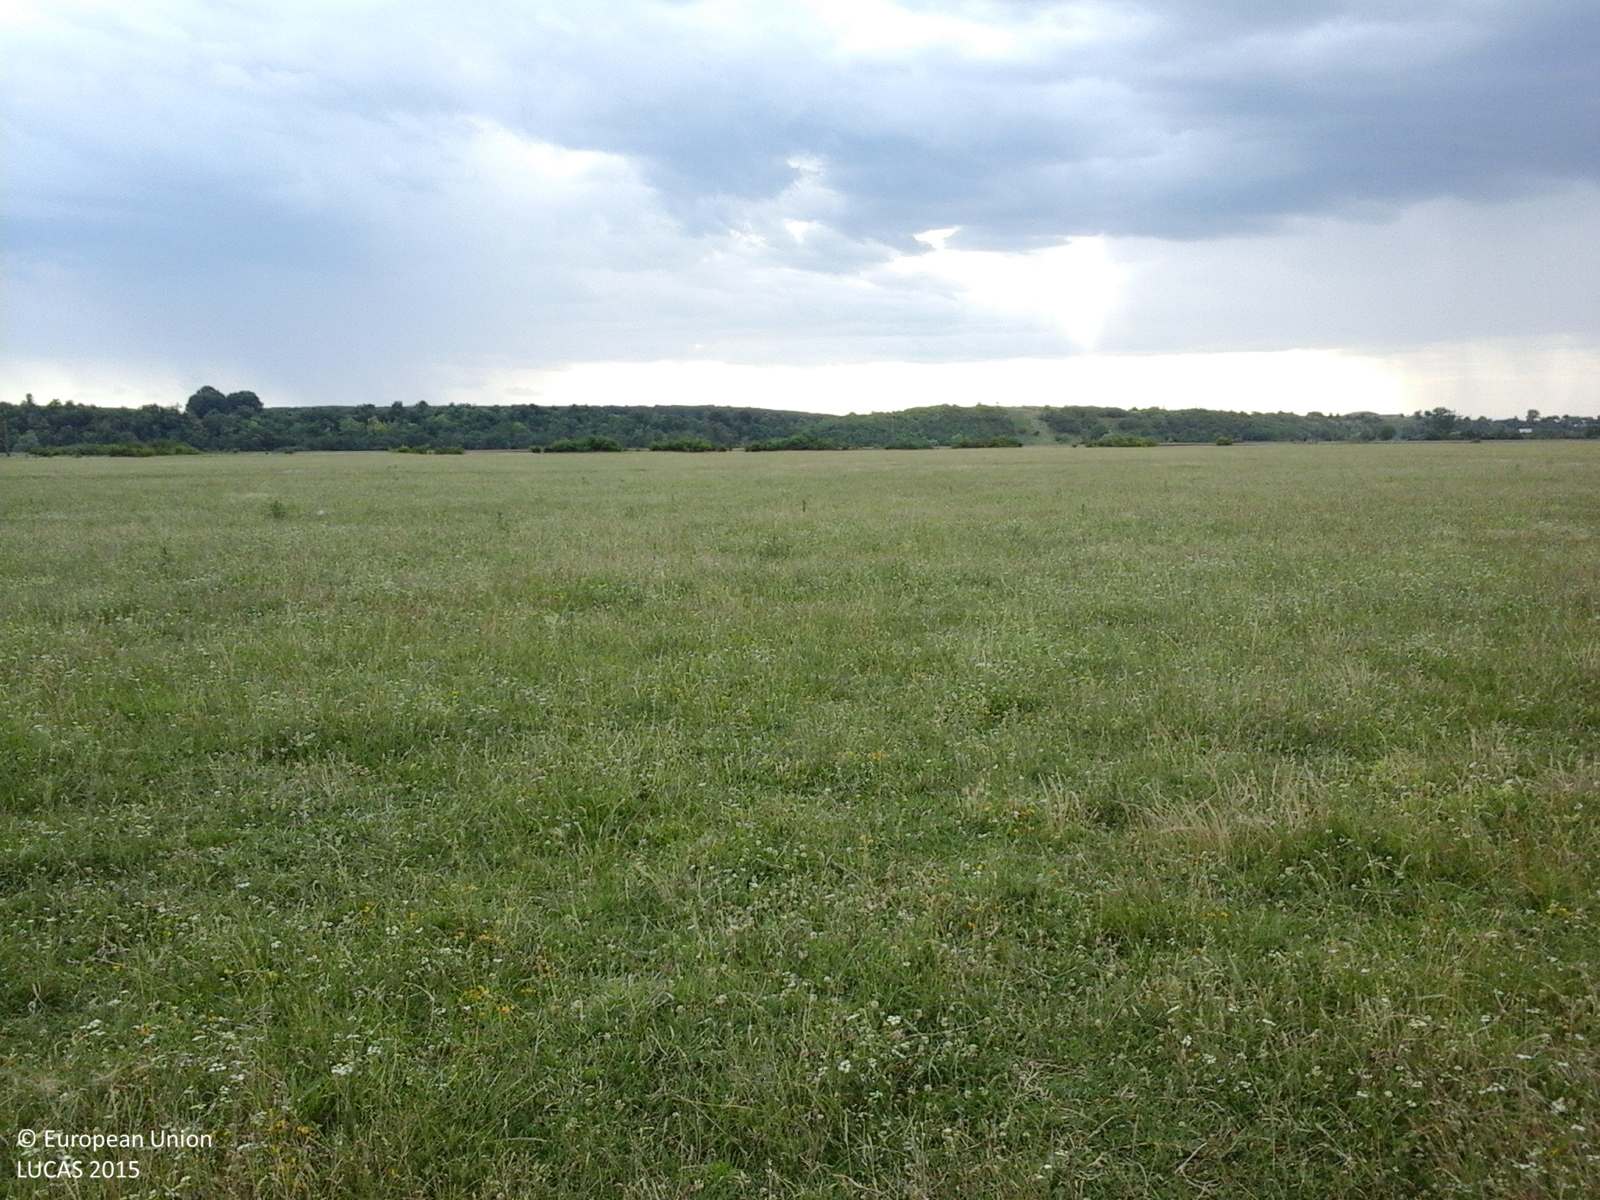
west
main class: Grassland
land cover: Grassland without tree/shrub cover
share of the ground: > 75 %
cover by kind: herbaceous plants 100 %
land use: Agriculture (excluding fallow land and kitchen gardens)
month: July
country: RO
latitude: 44.3671
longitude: 24.7694
